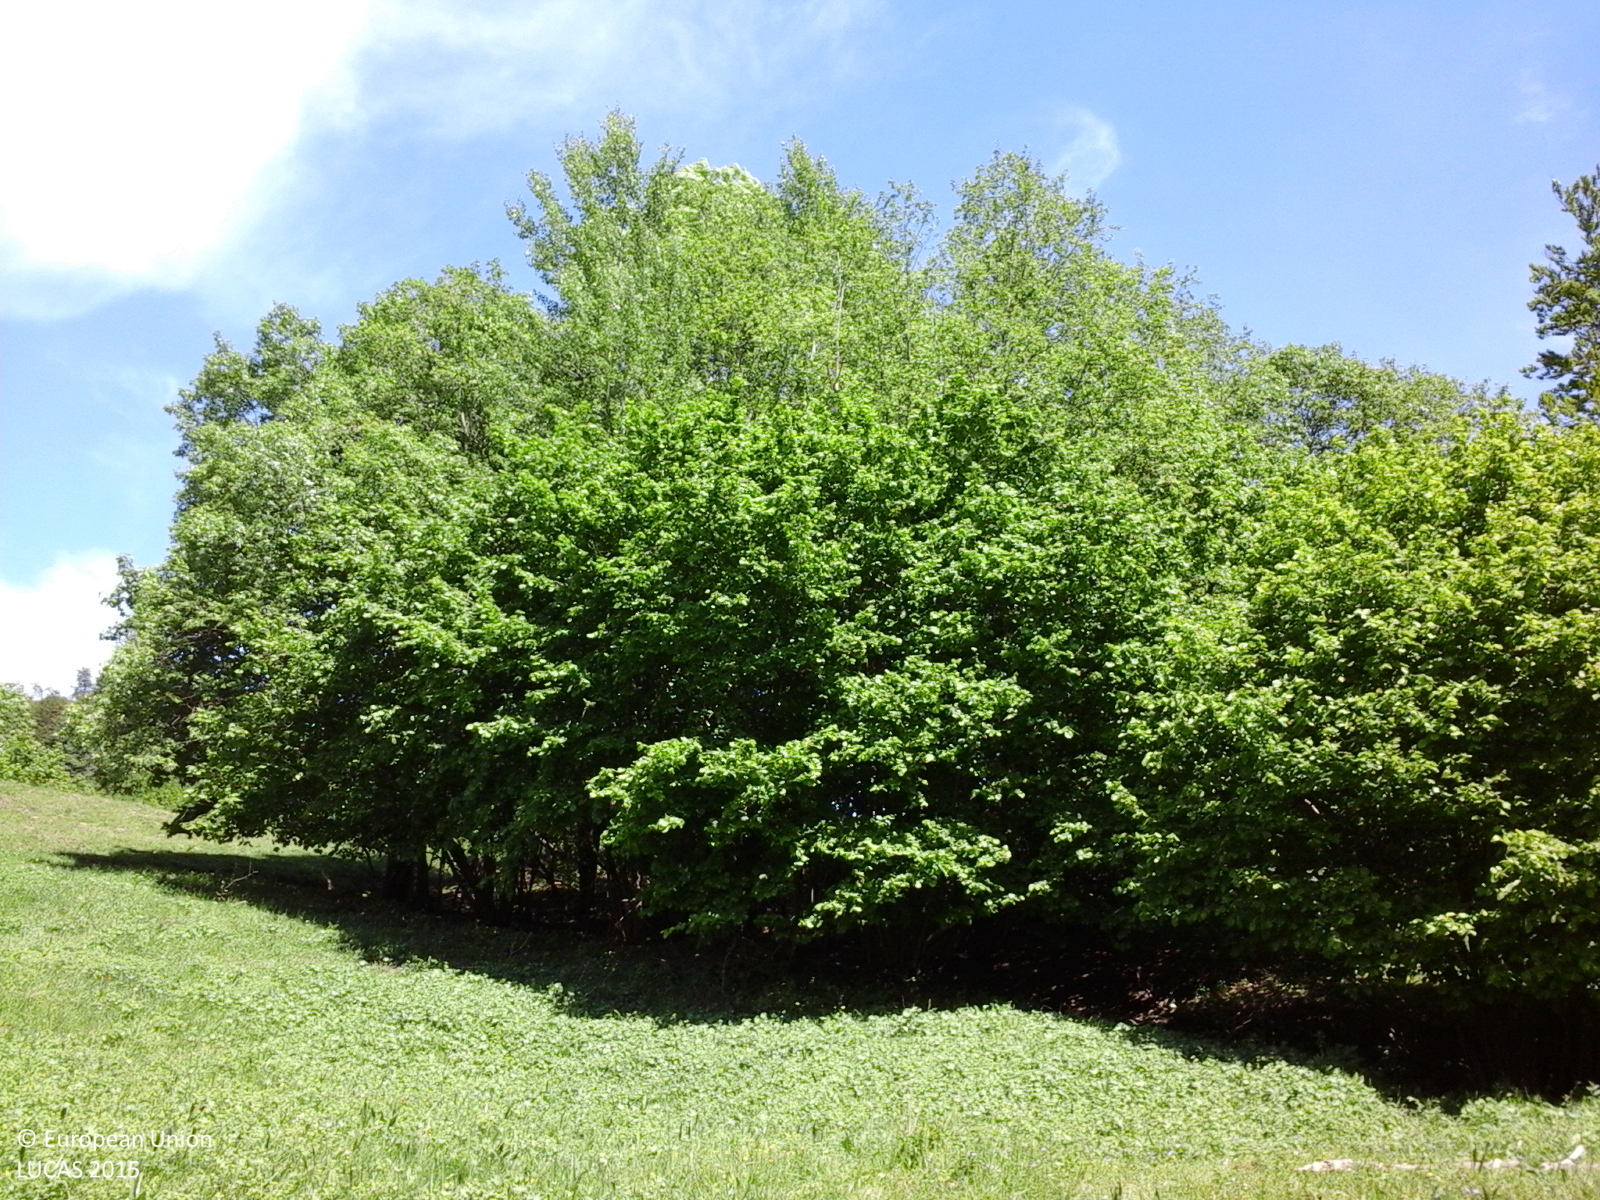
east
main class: Grassland
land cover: Grassland without tree/shrub cover
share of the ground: > 75 %
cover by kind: herbaceous plants 100 %
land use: Agriculture (excluding fallow land and kitchen gardens)
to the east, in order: Grassland without tree/shrub cover; Broadleaved woodland; Grassland without tree/shrub cover; Tracks; Grassland without tree/shrub cover; Broadleaved woodland; Grassland without tree/shrub cover; Tracks; Grassland without tree/shrub cover; Broadleaved woodland
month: May
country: RO
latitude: 45.3770
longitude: 25.7487
